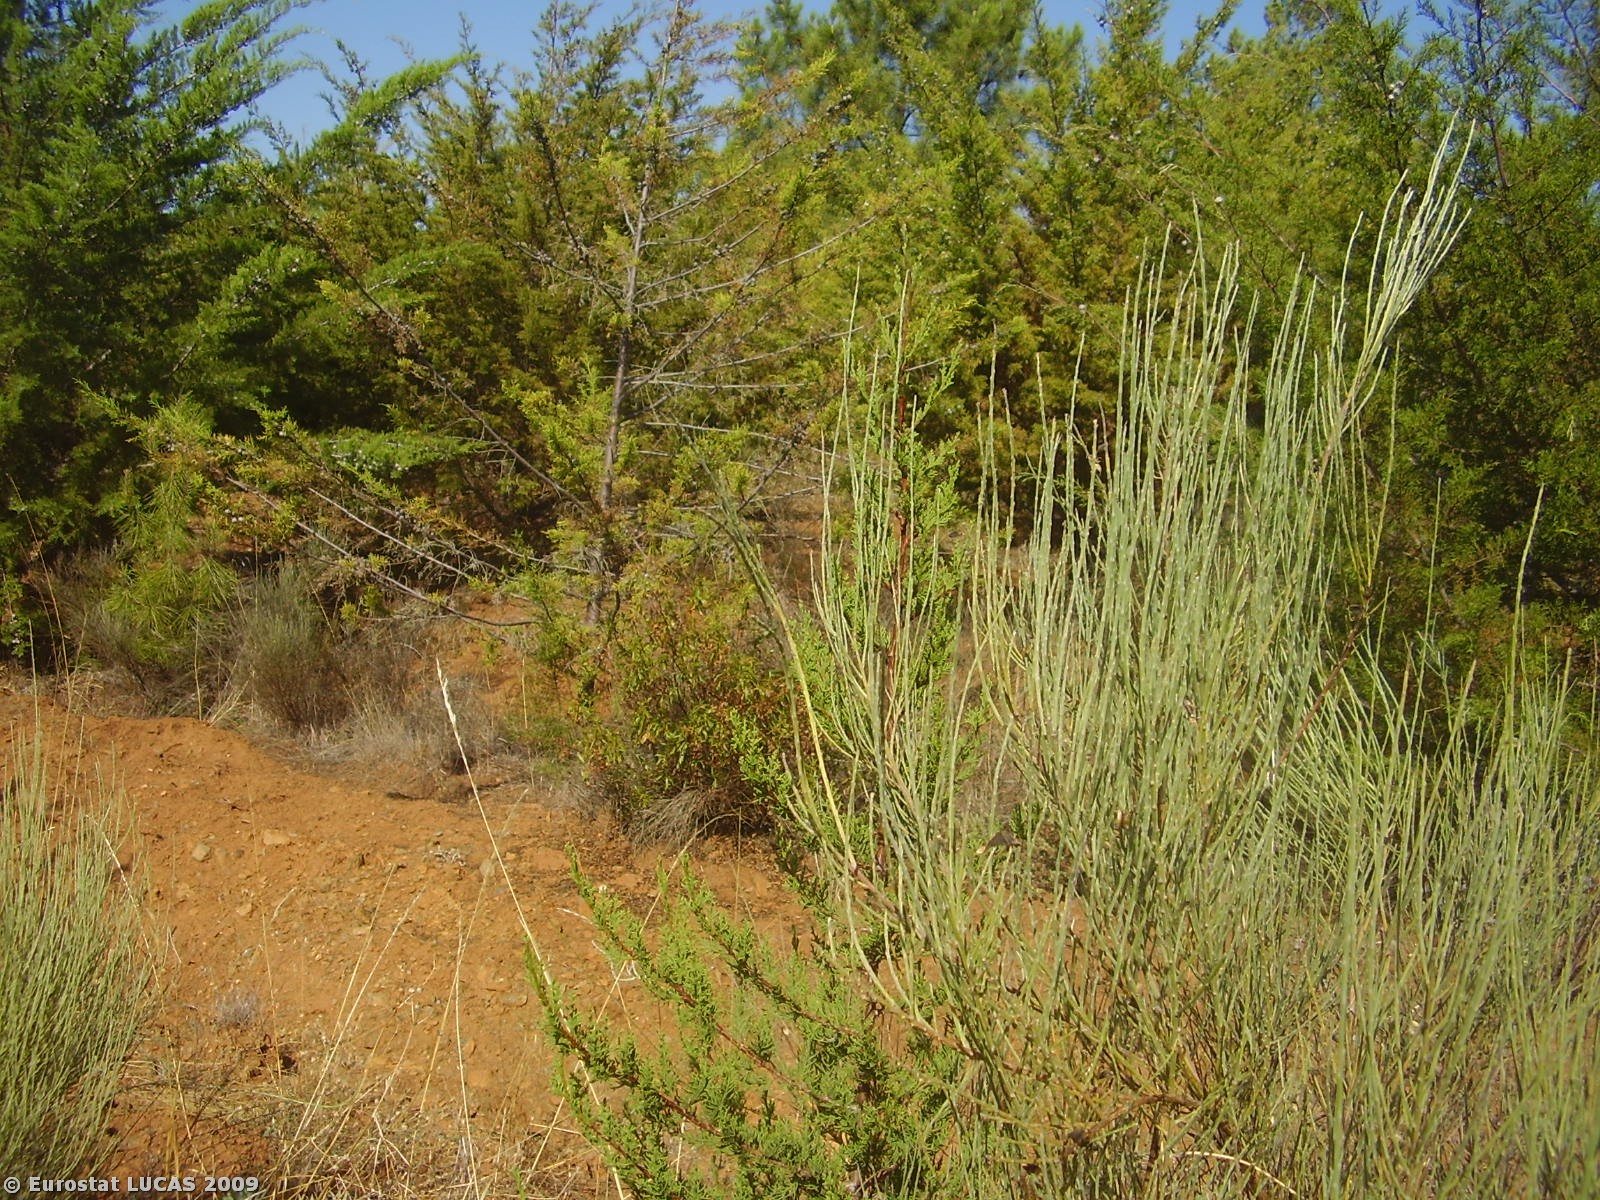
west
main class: Woodland
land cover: Coniferous woodland
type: coniferous forest of the mediterranean region
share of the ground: 25 - 50 %
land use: Forestry
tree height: > 5 m
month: August
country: PT
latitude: 41.4853
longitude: -6.8666
